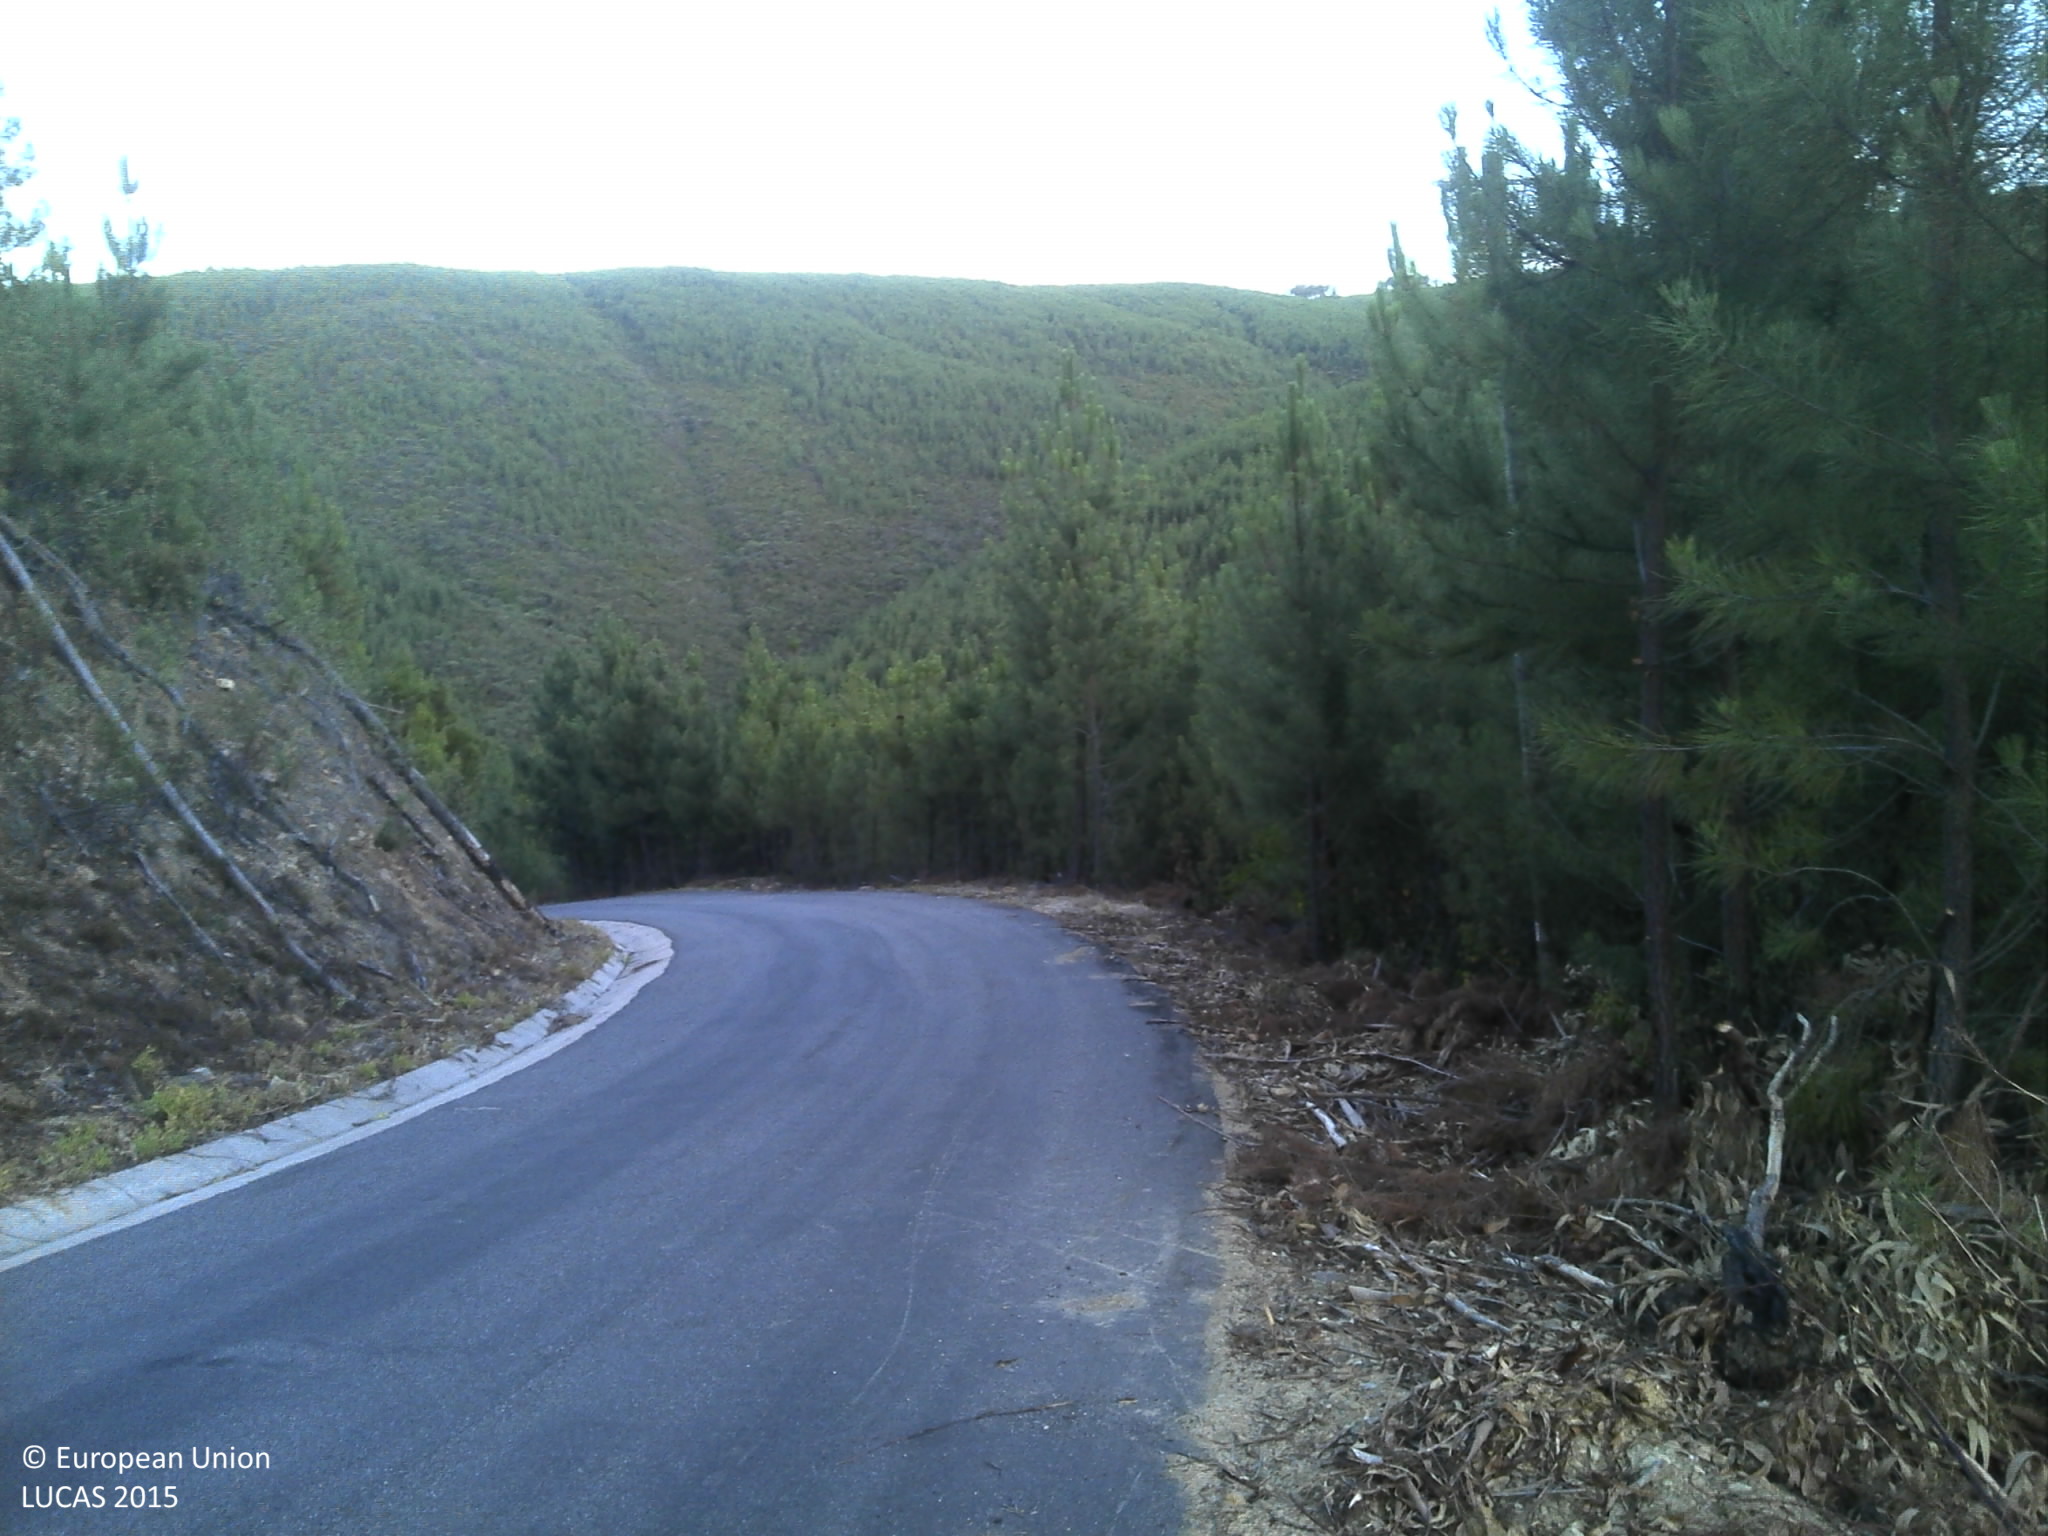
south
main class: Woodland
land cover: Pine dominated coniferous woodland
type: coniferous forest of the mediterranean region
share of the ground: 50 - 75 %
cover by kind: coniferous forest trees 50 %, shrubs 30 %, unconsolidated bare surface 20 %
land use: Forestry
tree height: < 5 m
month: July
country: PT
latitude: 39.8852
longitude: -7.7764
